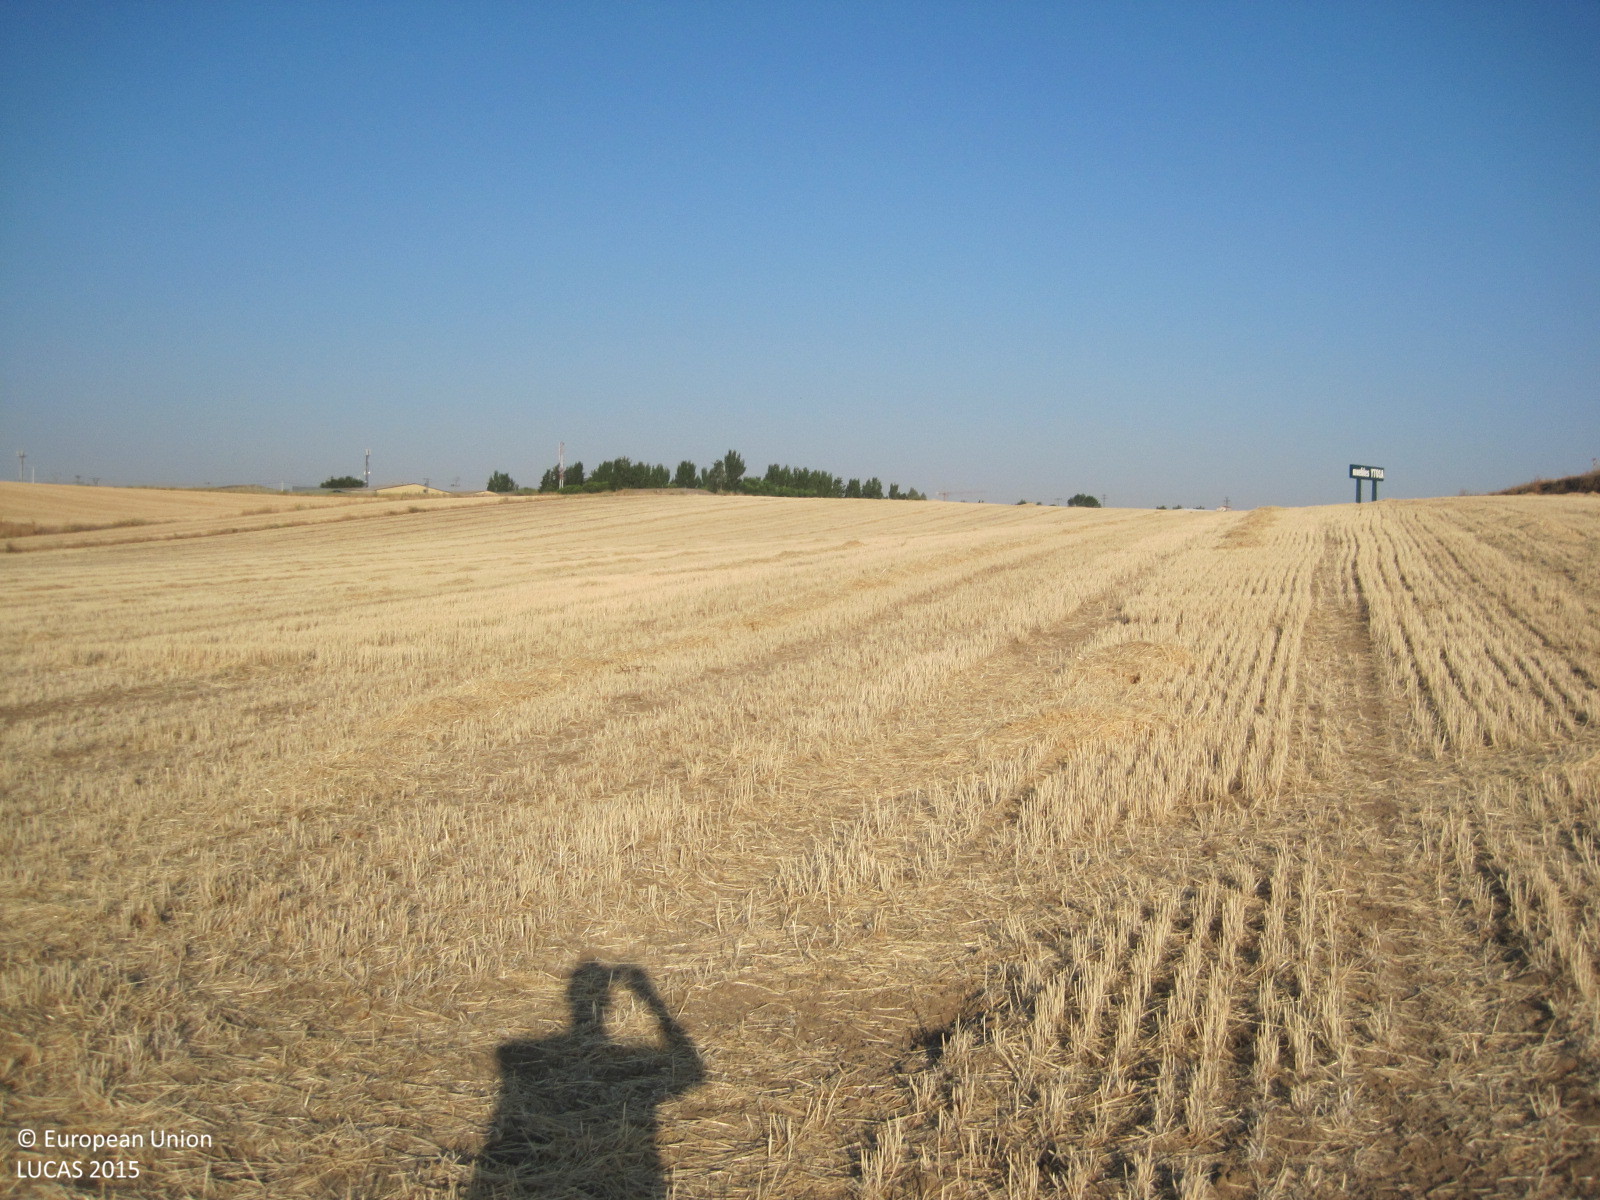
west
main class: Cropland
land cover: Barley
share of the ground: < 10 %
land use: Agriculture (excluding fallow land and kitchen gardens)
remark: Harvested field
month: July
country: ES
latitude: 40.1653
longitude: -3.8085
